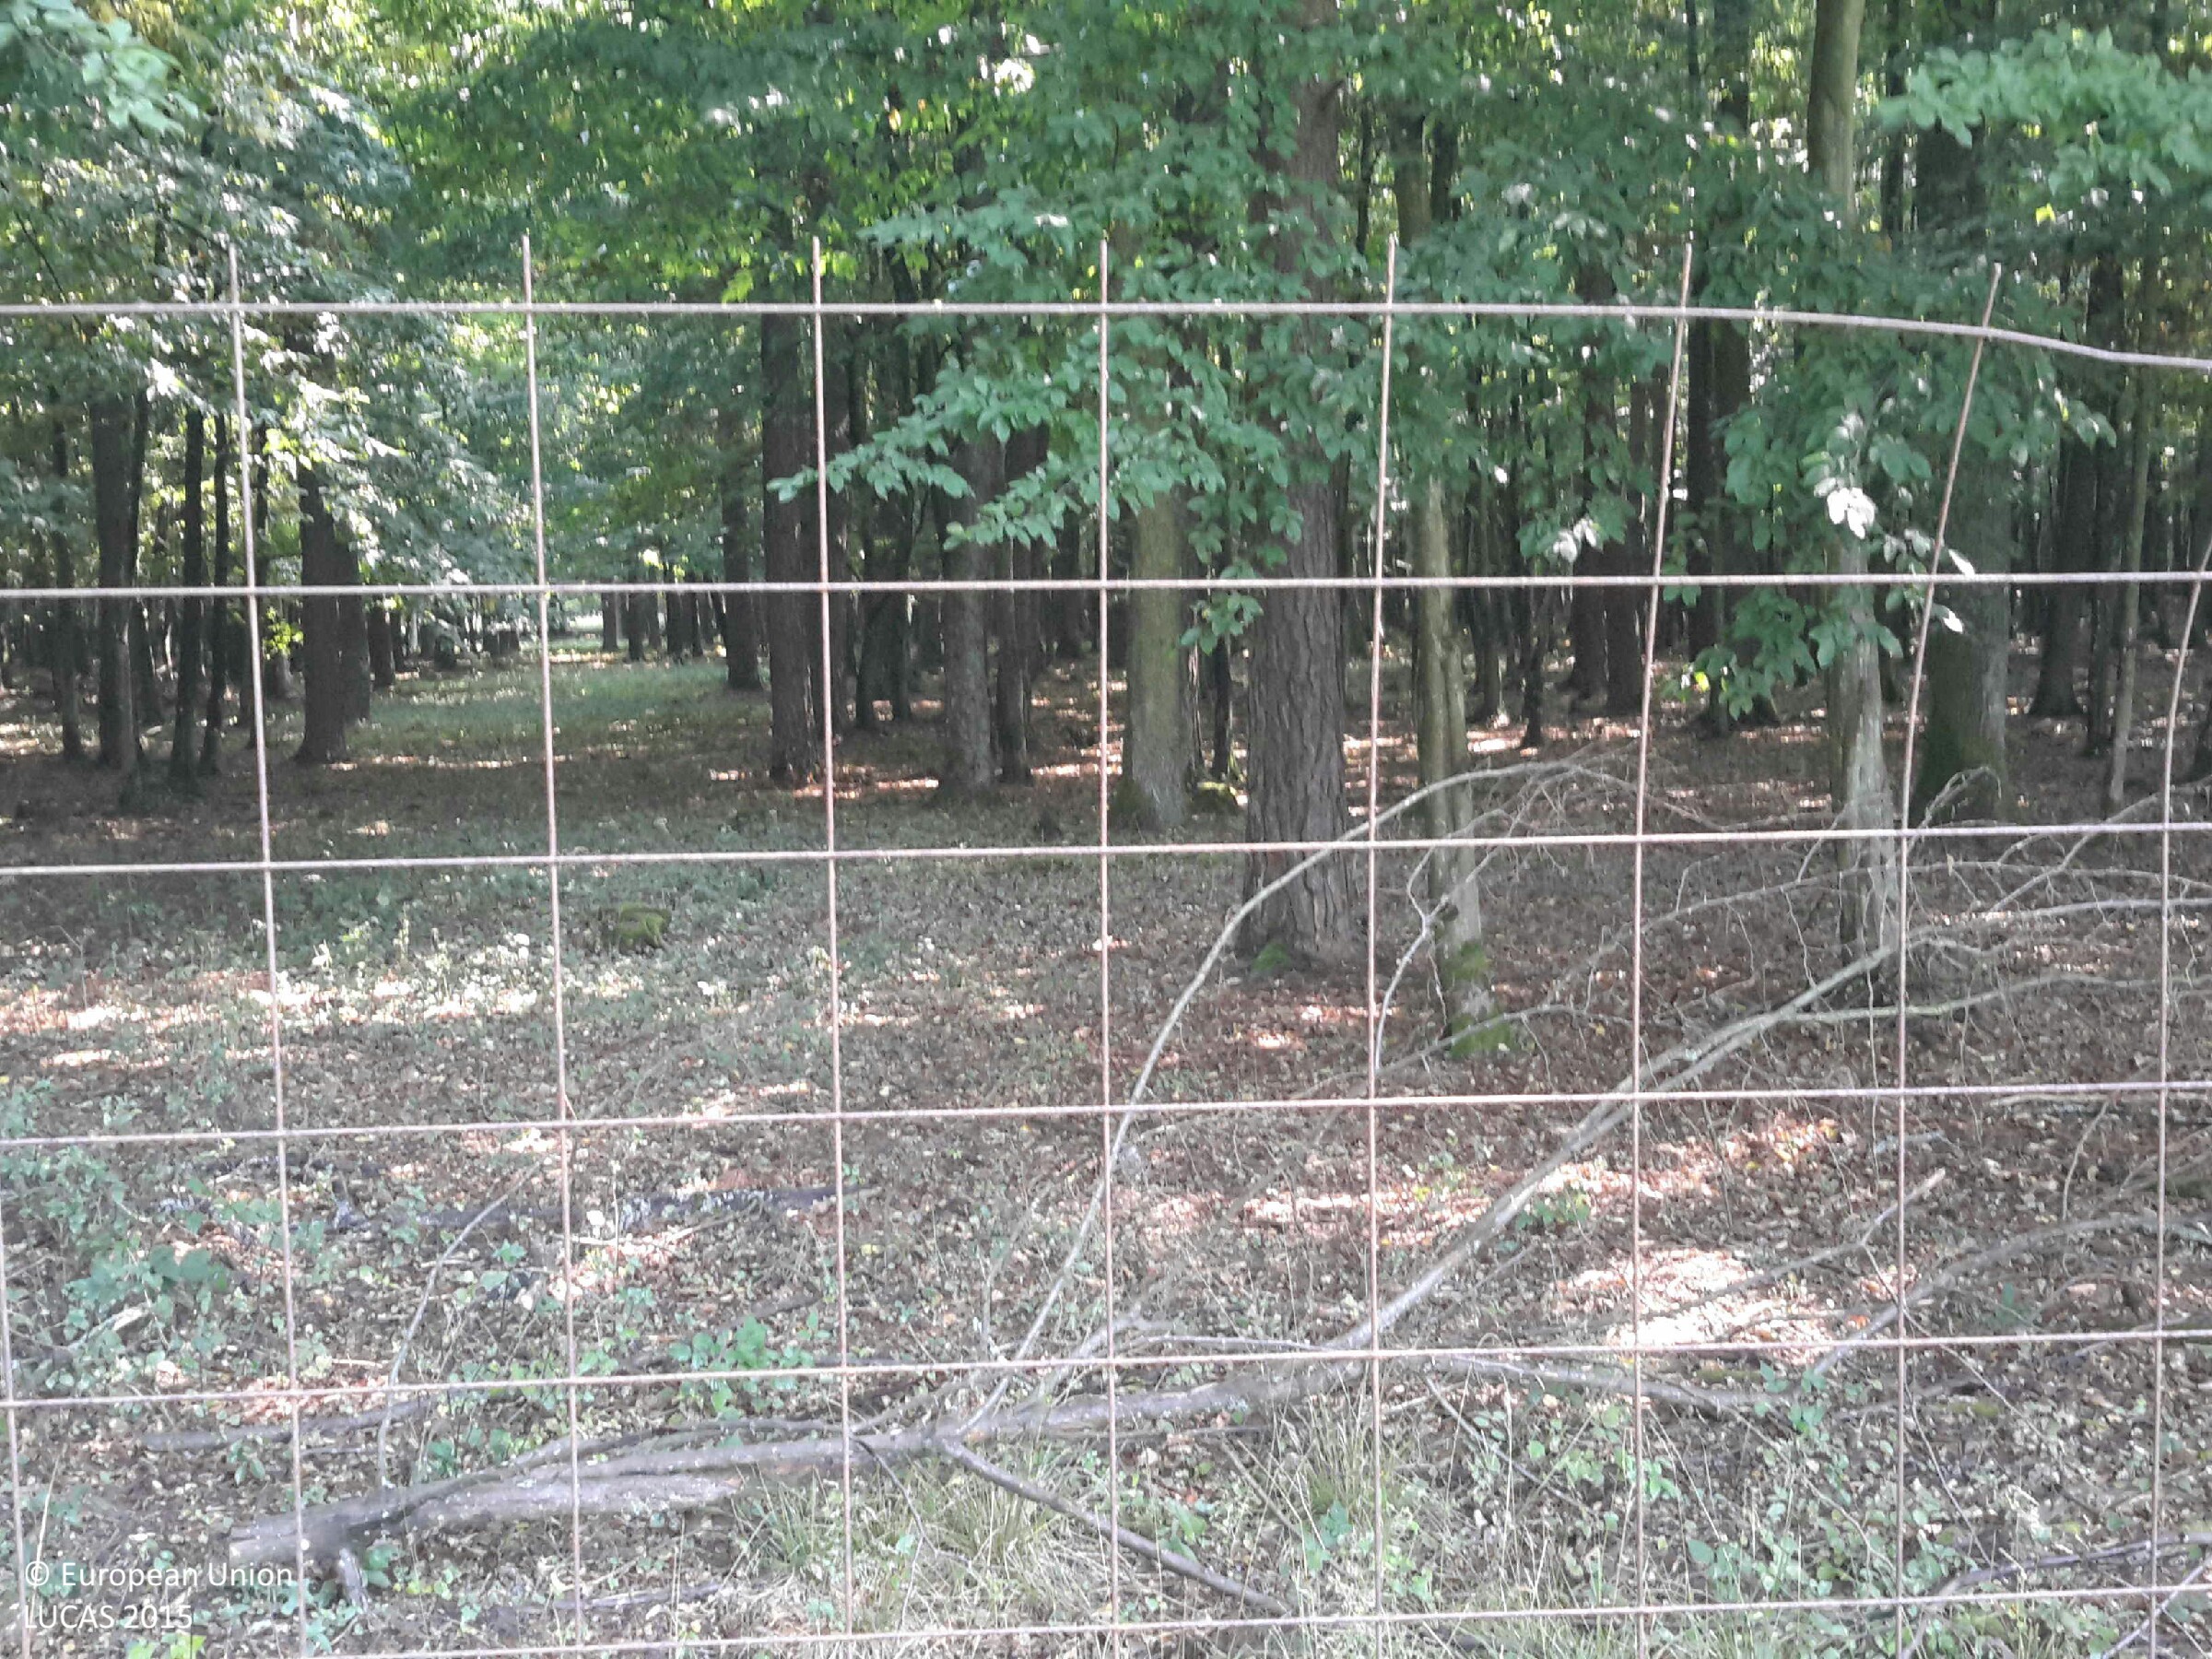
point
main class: Woodland
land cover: Broadleaved woodland
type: beech forest
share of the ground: > 75 %
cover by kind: broadleaved forest trees 90 %, herbaceous plants 10 %
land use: Forestry
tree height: > 5 m
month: August
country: HU
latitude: 47.1093
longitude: 16.5260
